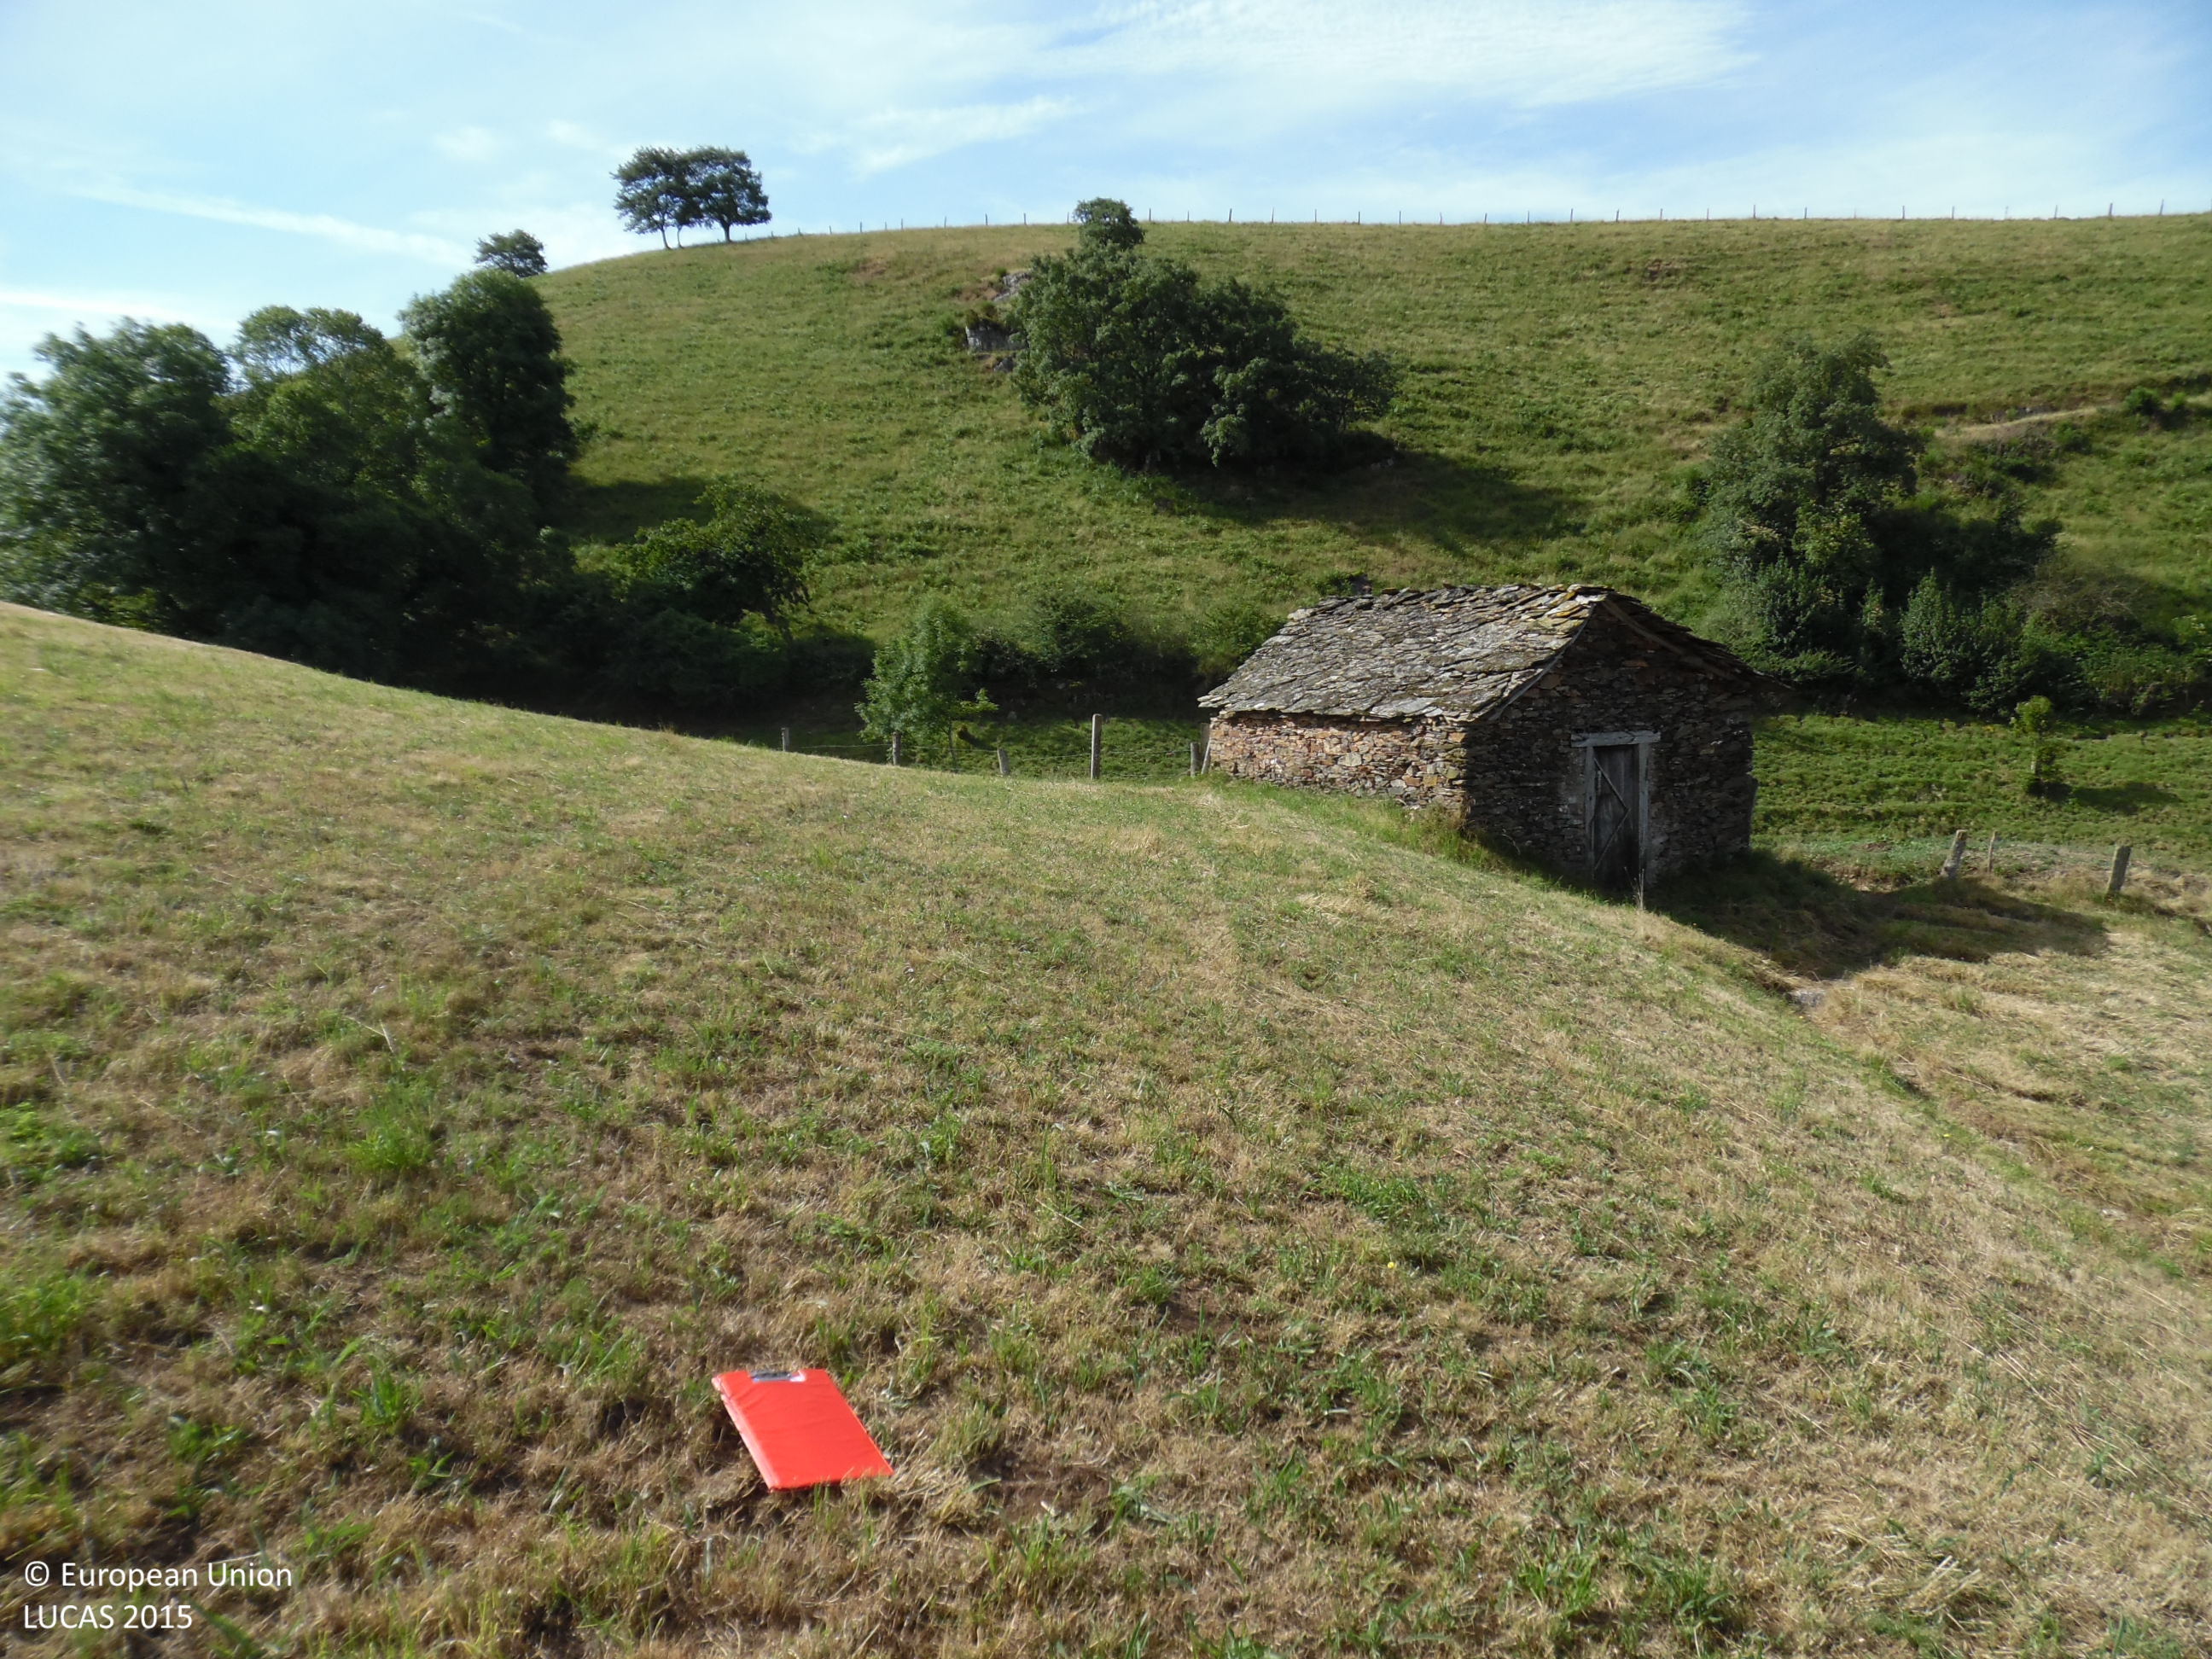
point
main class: Cropland
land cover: Temporary grasslands
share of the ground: > 75 %
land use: Agriculture (excluding fallow land and kitchen gardens)
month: July
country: ES
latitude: 43.1680
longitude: -6.5978
